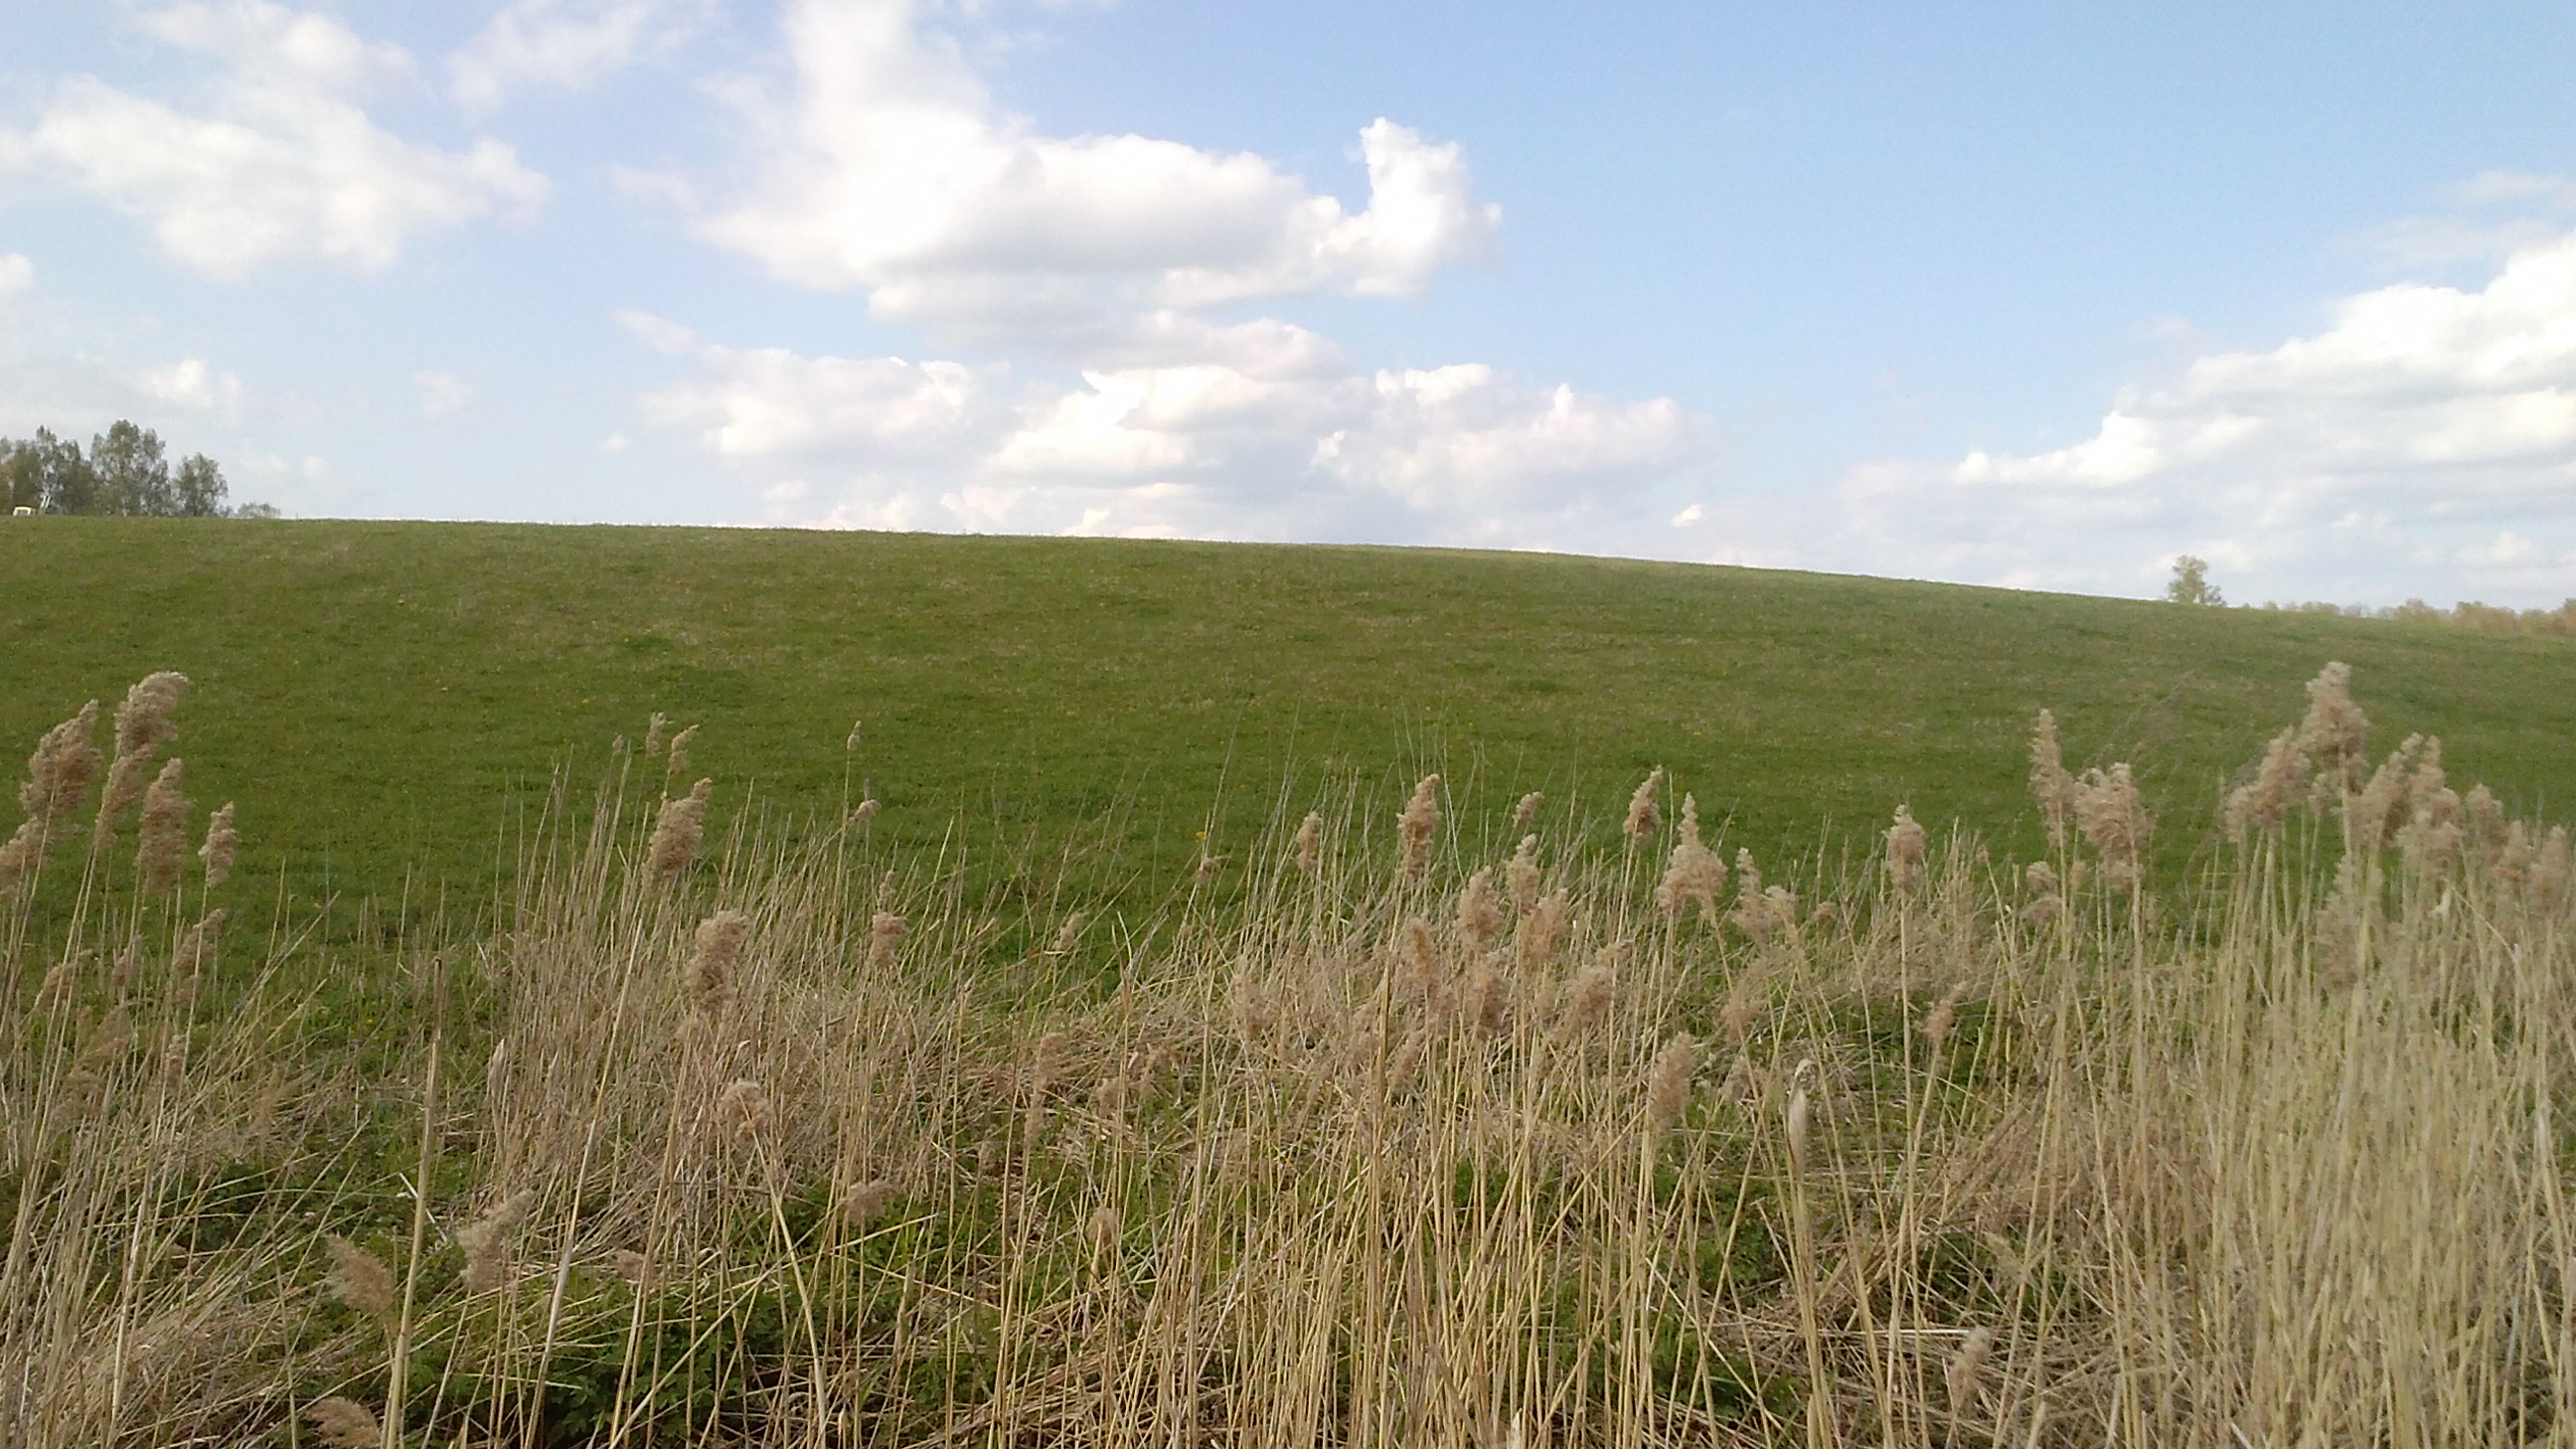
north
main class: Grassland
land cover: Grassland without tree/shrub cover
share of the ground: > 75 %
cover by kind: herbaceous plants 100 %
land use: Agriculture (excluding fallow land and kitchen gardens)
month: May
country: LV
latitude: 55.9452
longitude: 27.3912
